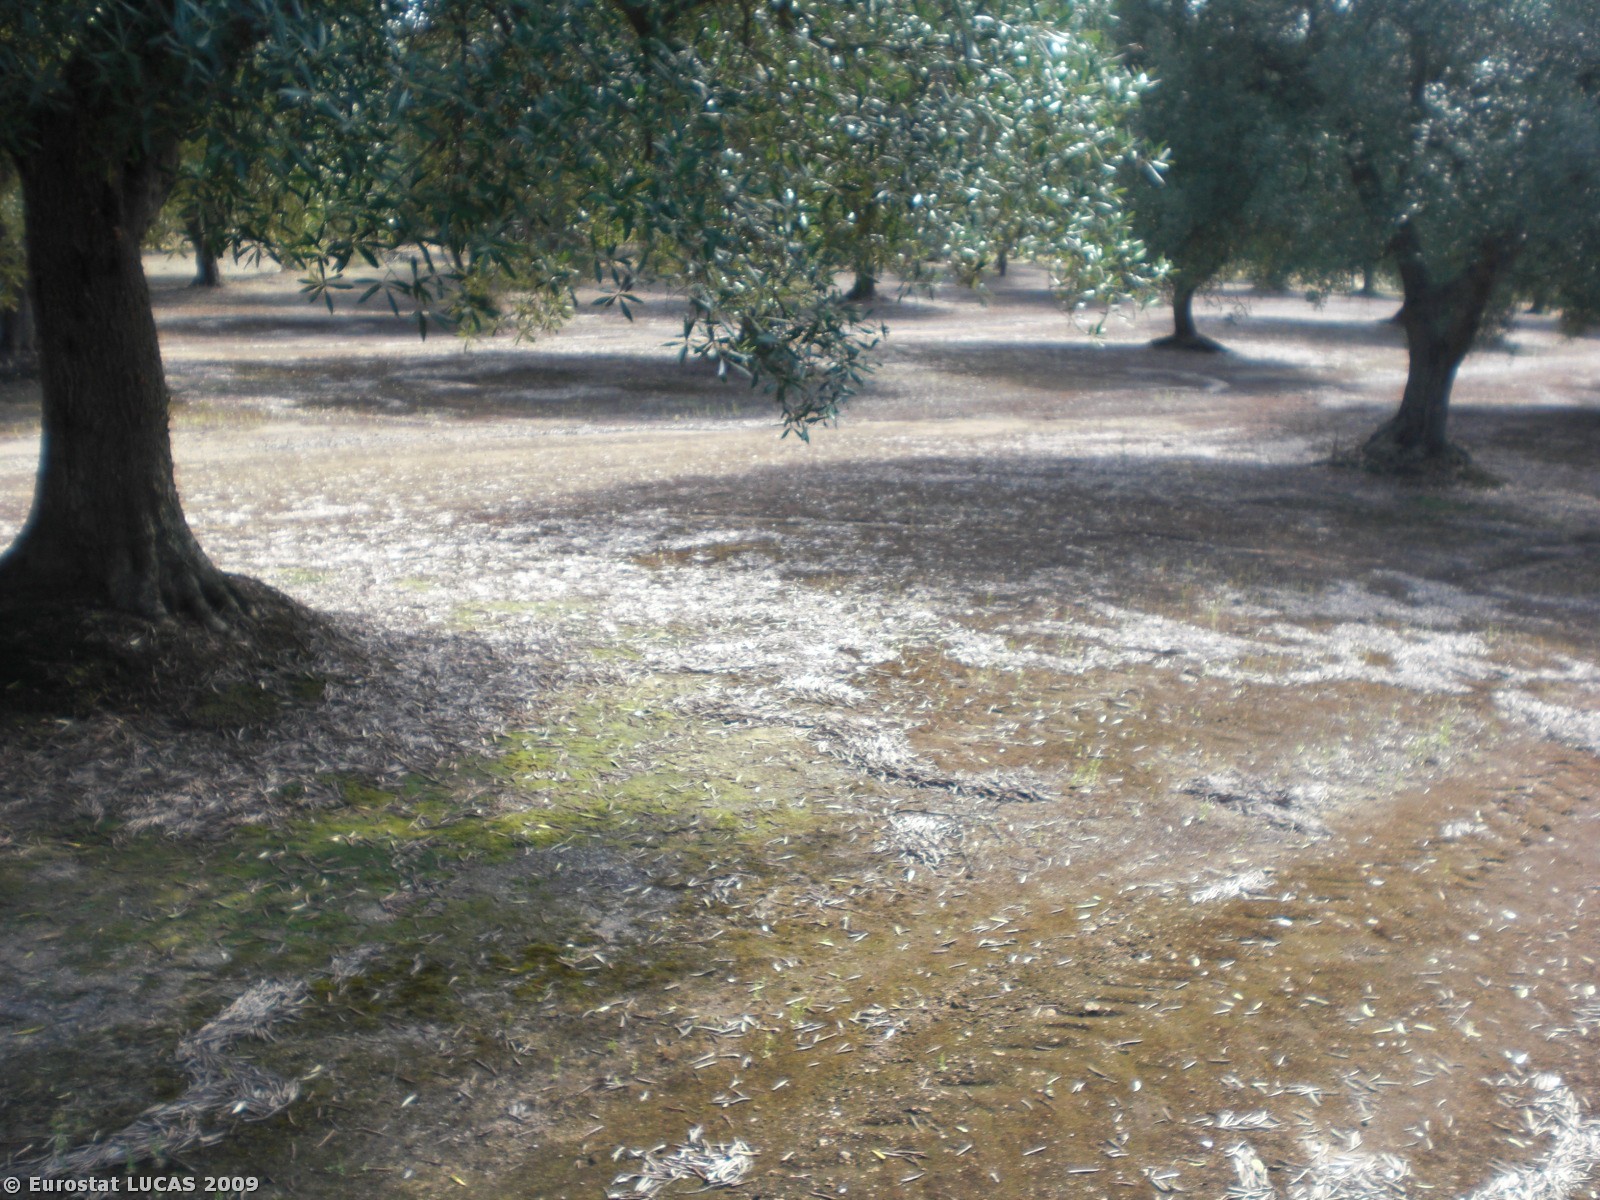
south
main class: Cropland
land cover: Olive groves
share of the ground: > 75 %
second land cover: Bare land
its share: 50 - 75 %
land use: Agriculture (excluding fallow land and kitchen gardens)
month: July
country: IT
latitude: 40.4731
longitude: 18.1502
